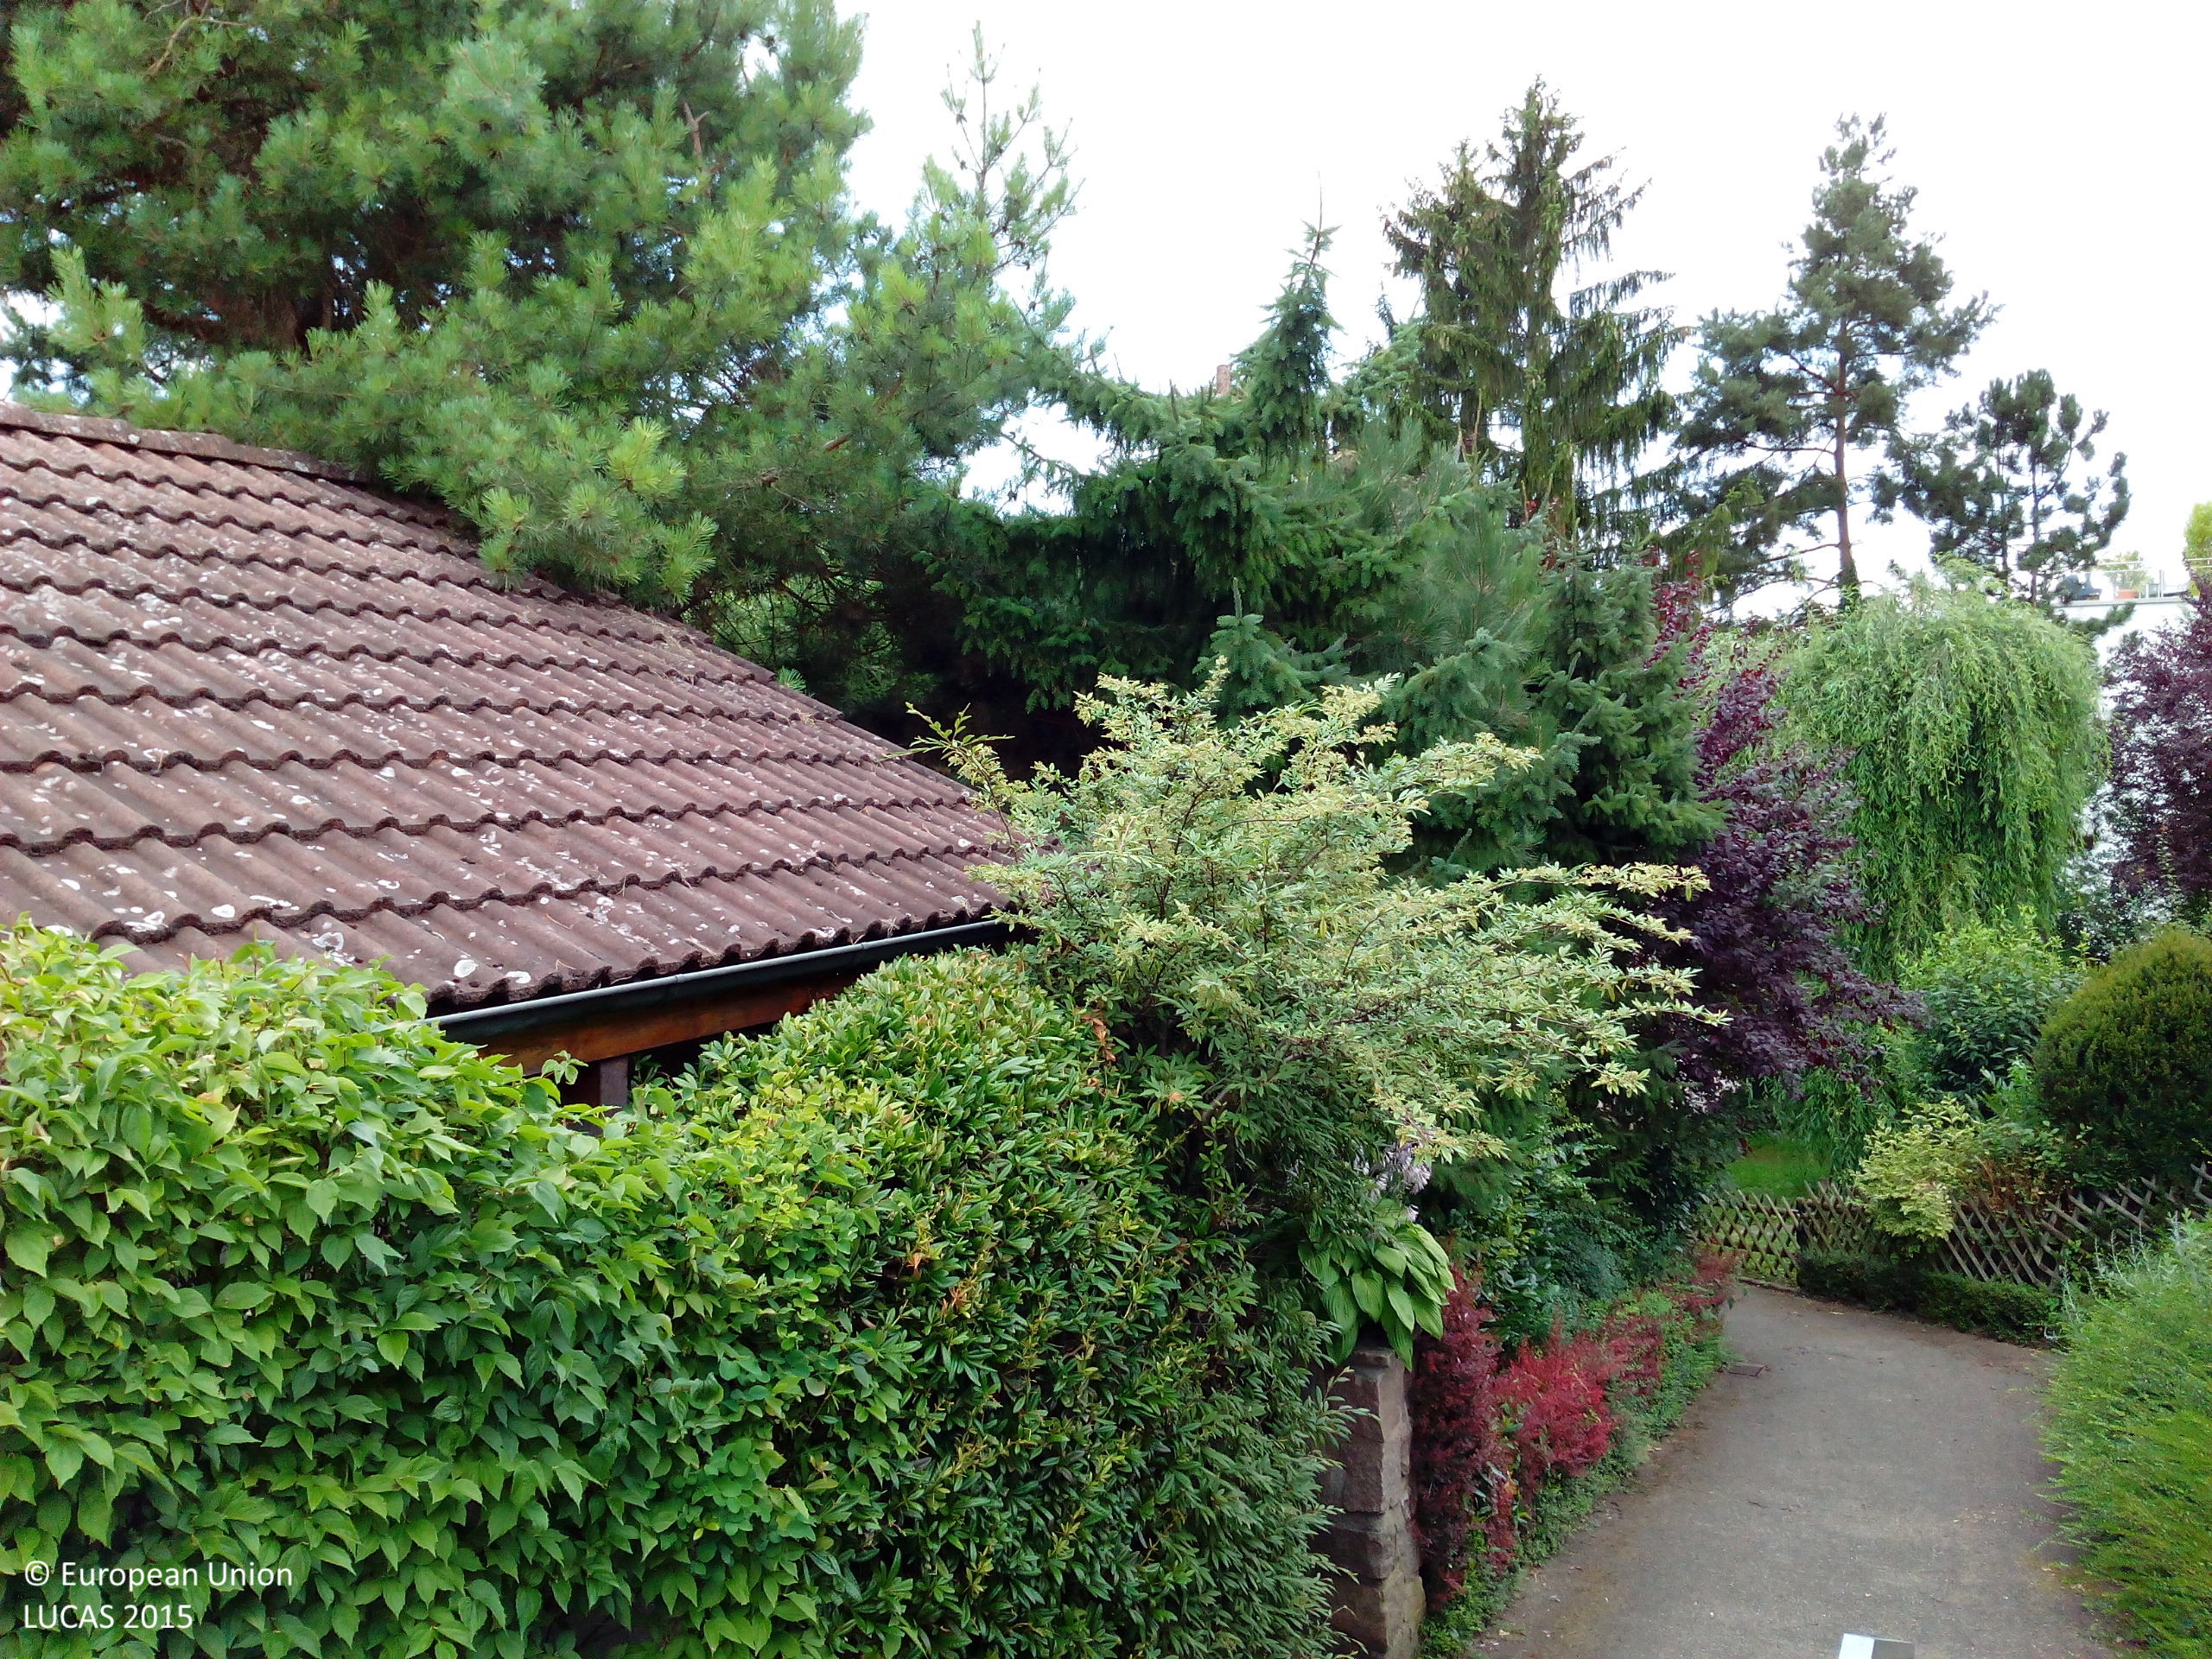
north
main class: Woodland
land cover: Other coniferous woodland
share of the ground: 50 - 75 %
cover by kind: coniferous forest trees 60 %, shrubs 30 %, herbaceous plants 5 %, consolidated bare surface 5 %
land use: Residential
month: July
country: DE
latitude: 47.6403
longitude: 7.6455
